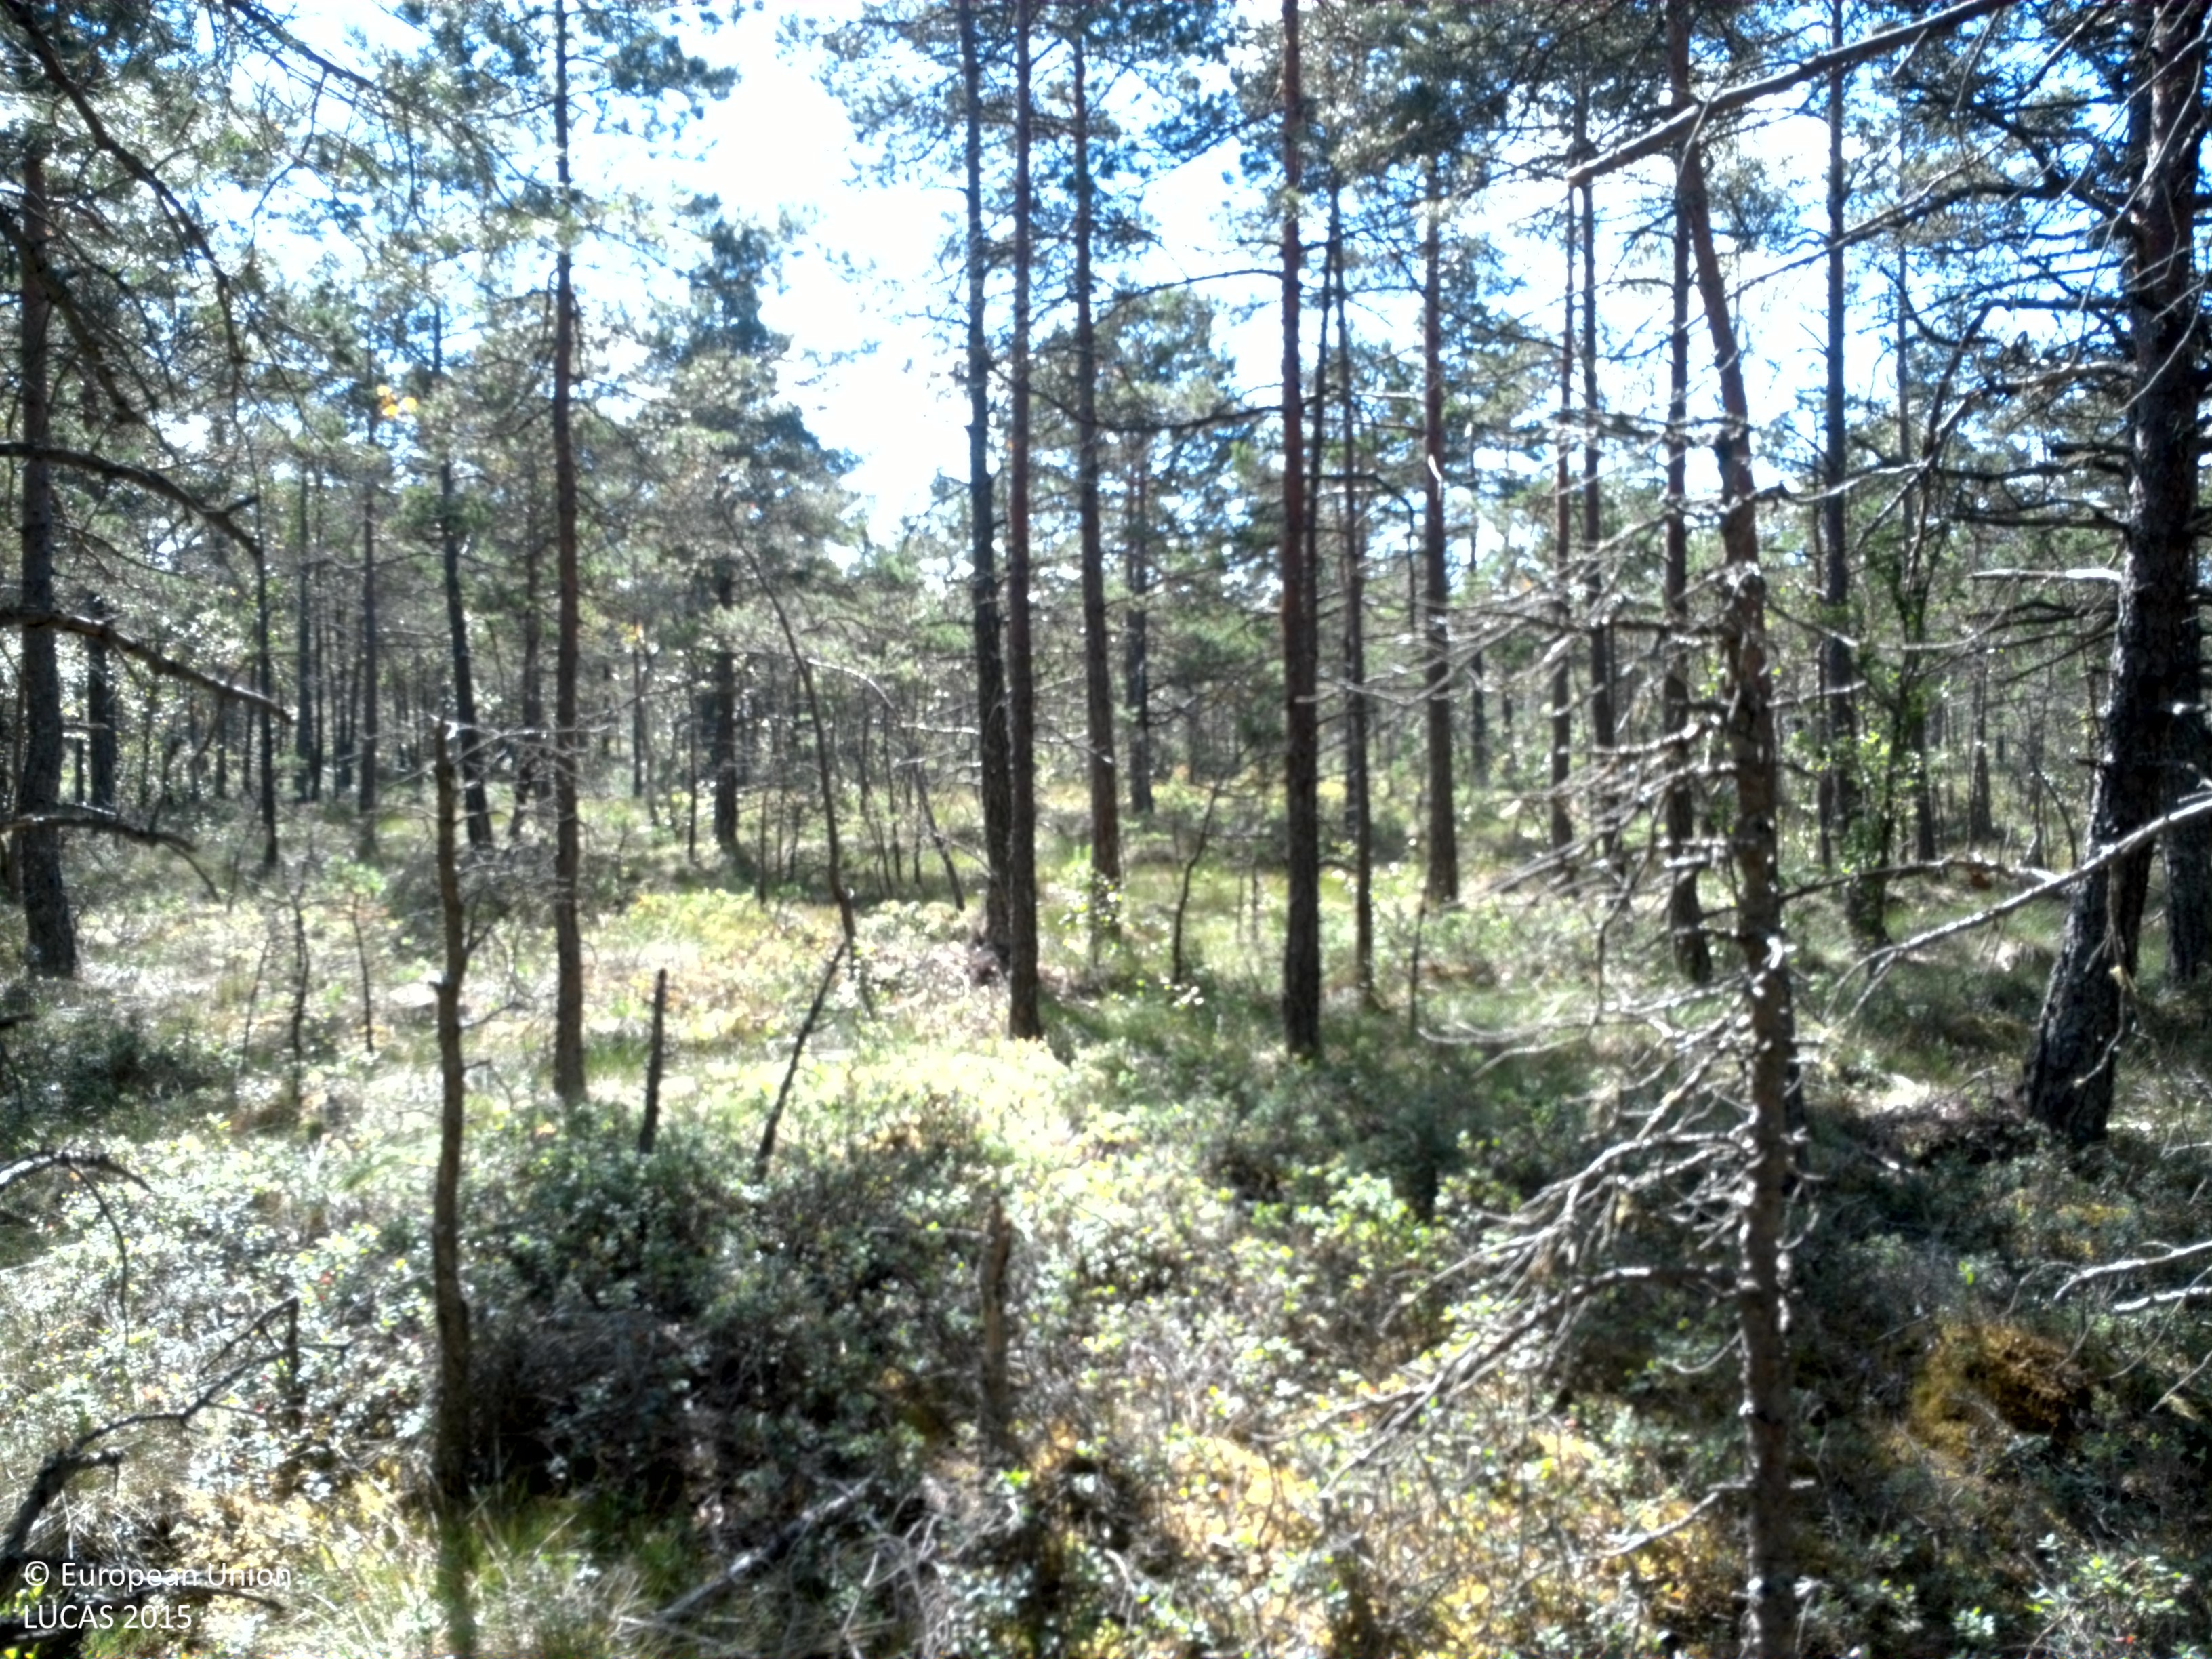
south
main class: Woodland
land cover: Pine dominated mixed woodland
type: boreal forest
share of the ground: 25 - 50 %
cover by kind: coniferous forest trees 30 %, shrubs 30 %, broadleaved forest trees 20 %, lichens and mosses 15 %, herbaceous plants 5 %
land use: Semi-natural and natural areas not in use
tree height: > 5 m
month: August
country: SE
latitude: 58.2163
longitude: 13.2458
